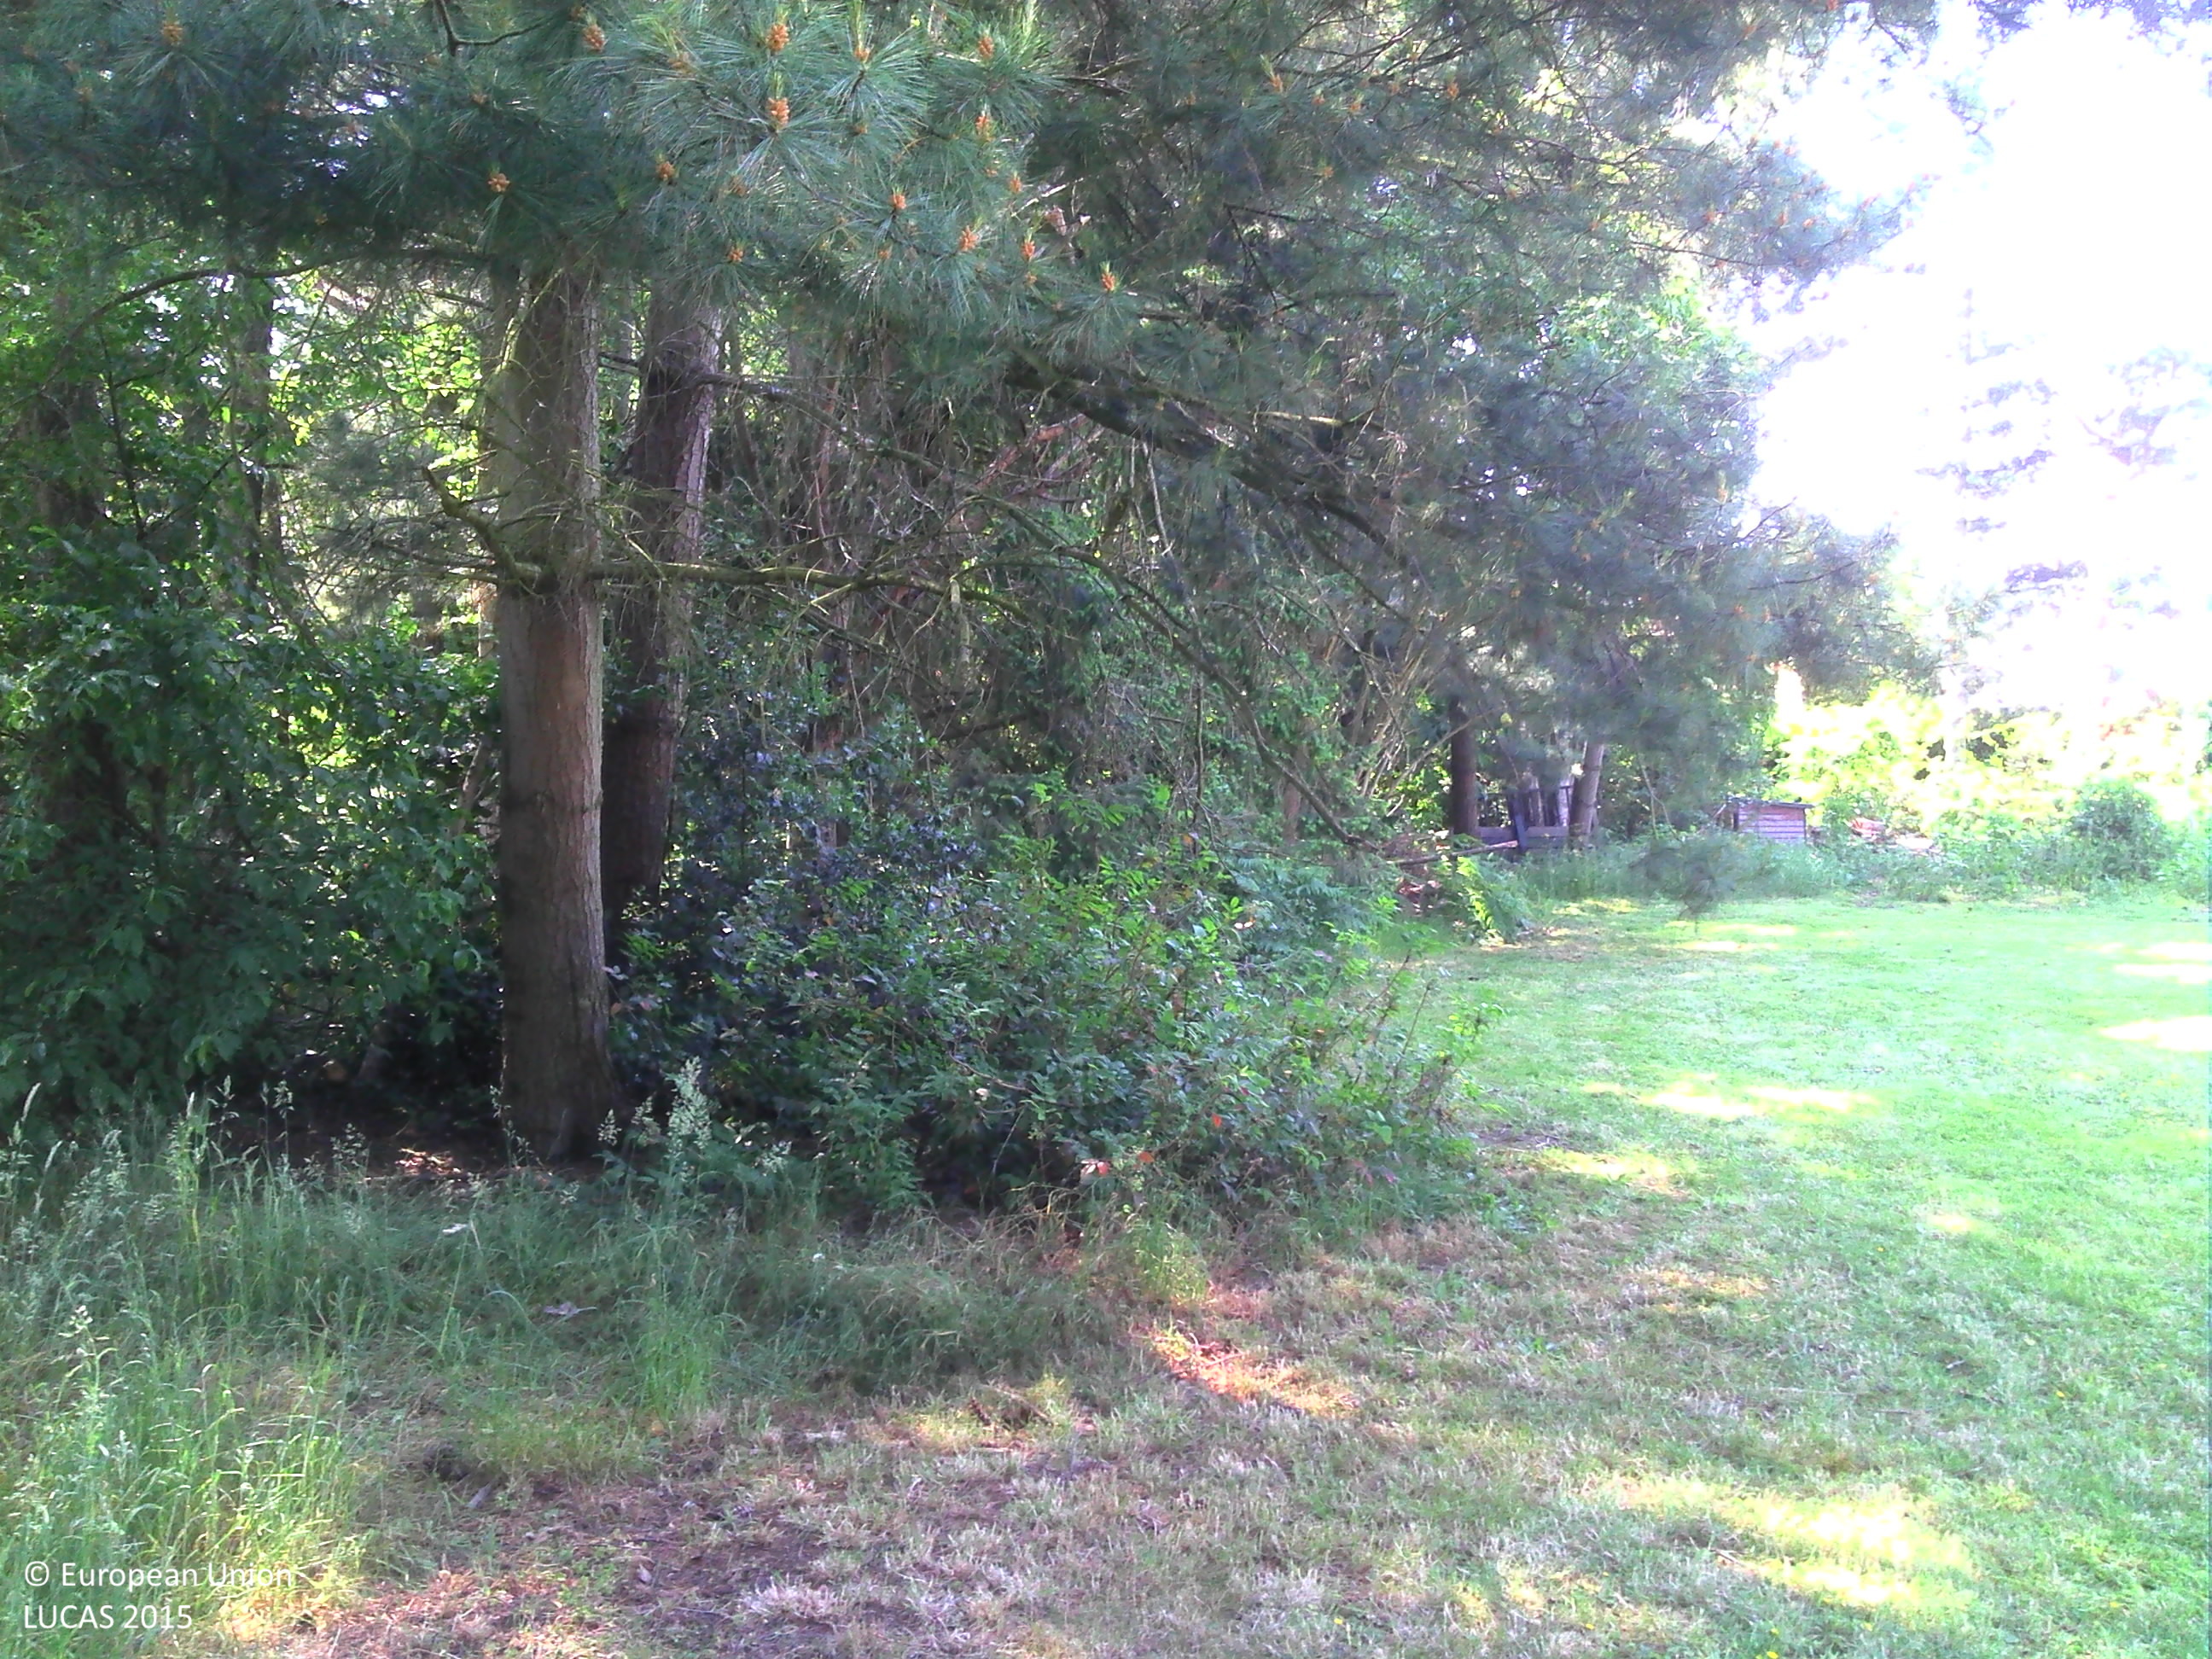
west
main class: Woodland
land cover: Other mixed woodland
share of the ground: > 75 %
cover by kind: broadleaved forest trees 70 %, coniferous forest trees 25 %, herbaceous plants 5 %
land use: Residential
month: June
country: BE
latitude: 50.9478
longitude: 5.2008
